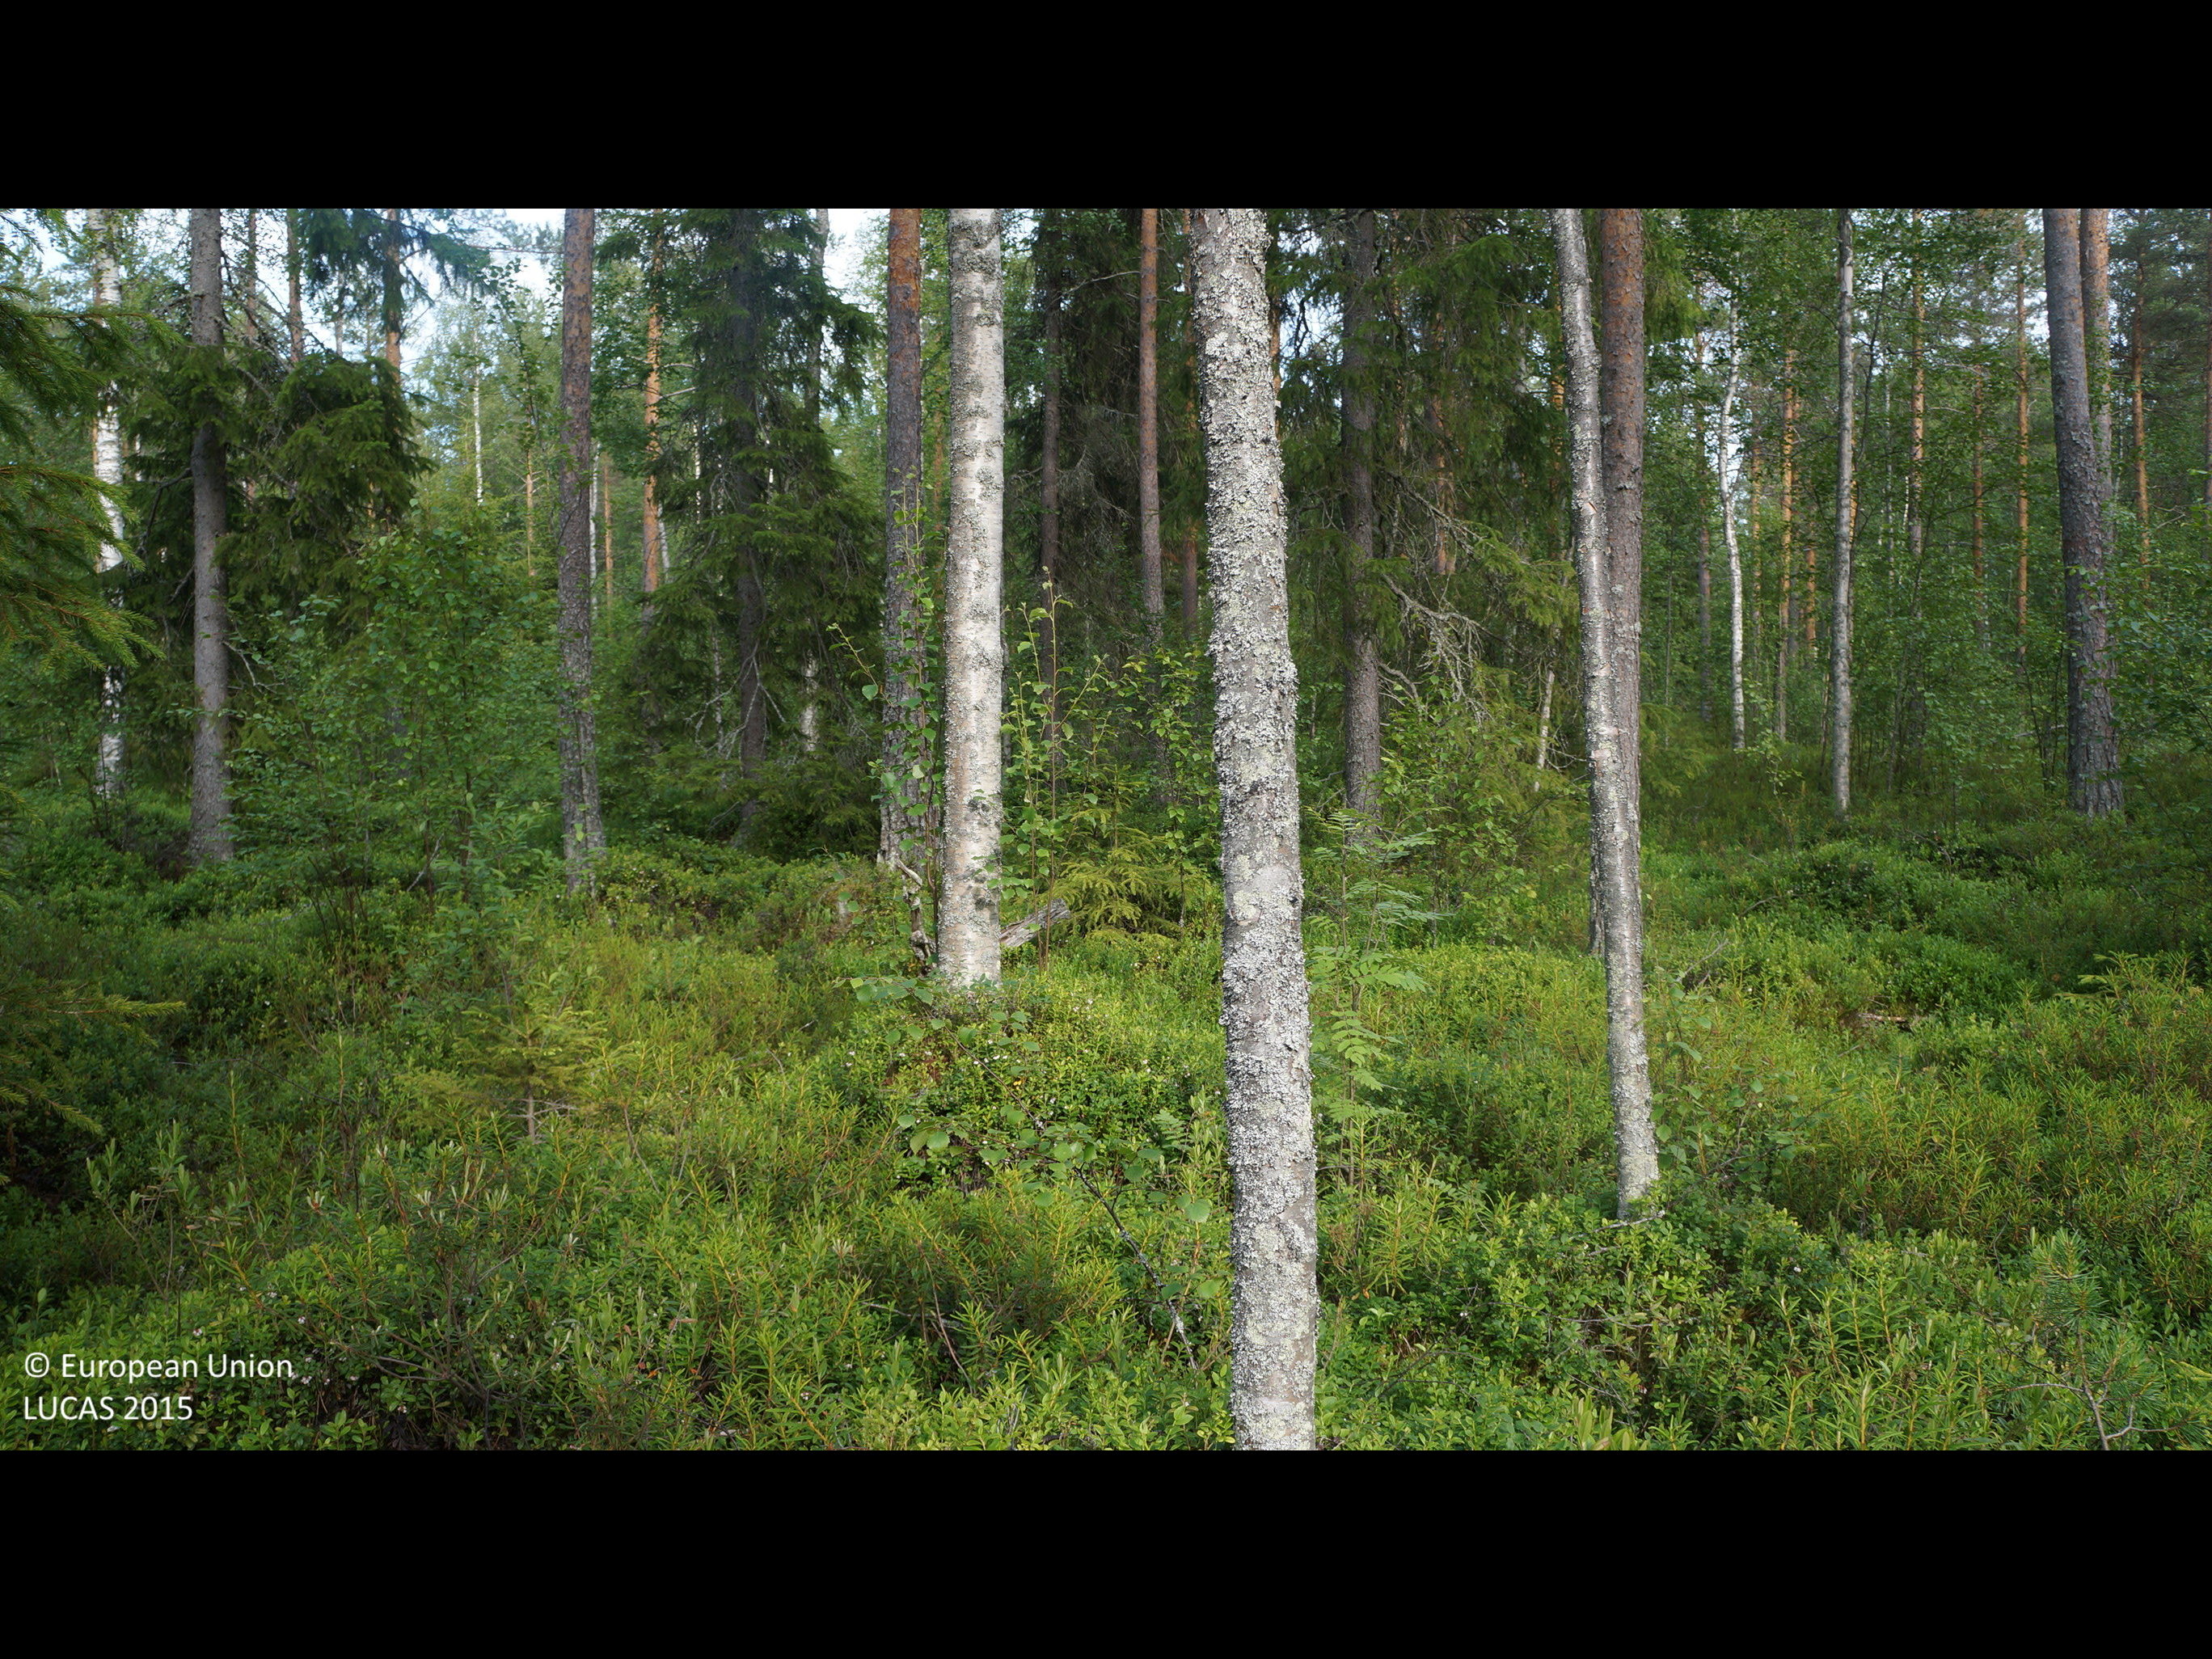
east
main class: Woodland
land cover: Other mixed woodland
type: boreal forest
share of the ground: 50 - 75 %
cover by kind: shrubs 40 %, coniferous forest trees 35 %, broadleaved forest trees 15 %, herbaceous plants 5 %, lichens and mosses 5 %
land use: Forestry
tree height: > 5 m
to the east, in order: Other mixed woodland; Ditches and canals; Other mixed woodland; Pine dominated mixed woodland; Spruce dominated mixed woodland; Pine dominated mixed woodland; Ditches and canals; Pine dominated mixed woodland
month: July
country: FI
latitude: 64.6702
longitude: 24.6718
